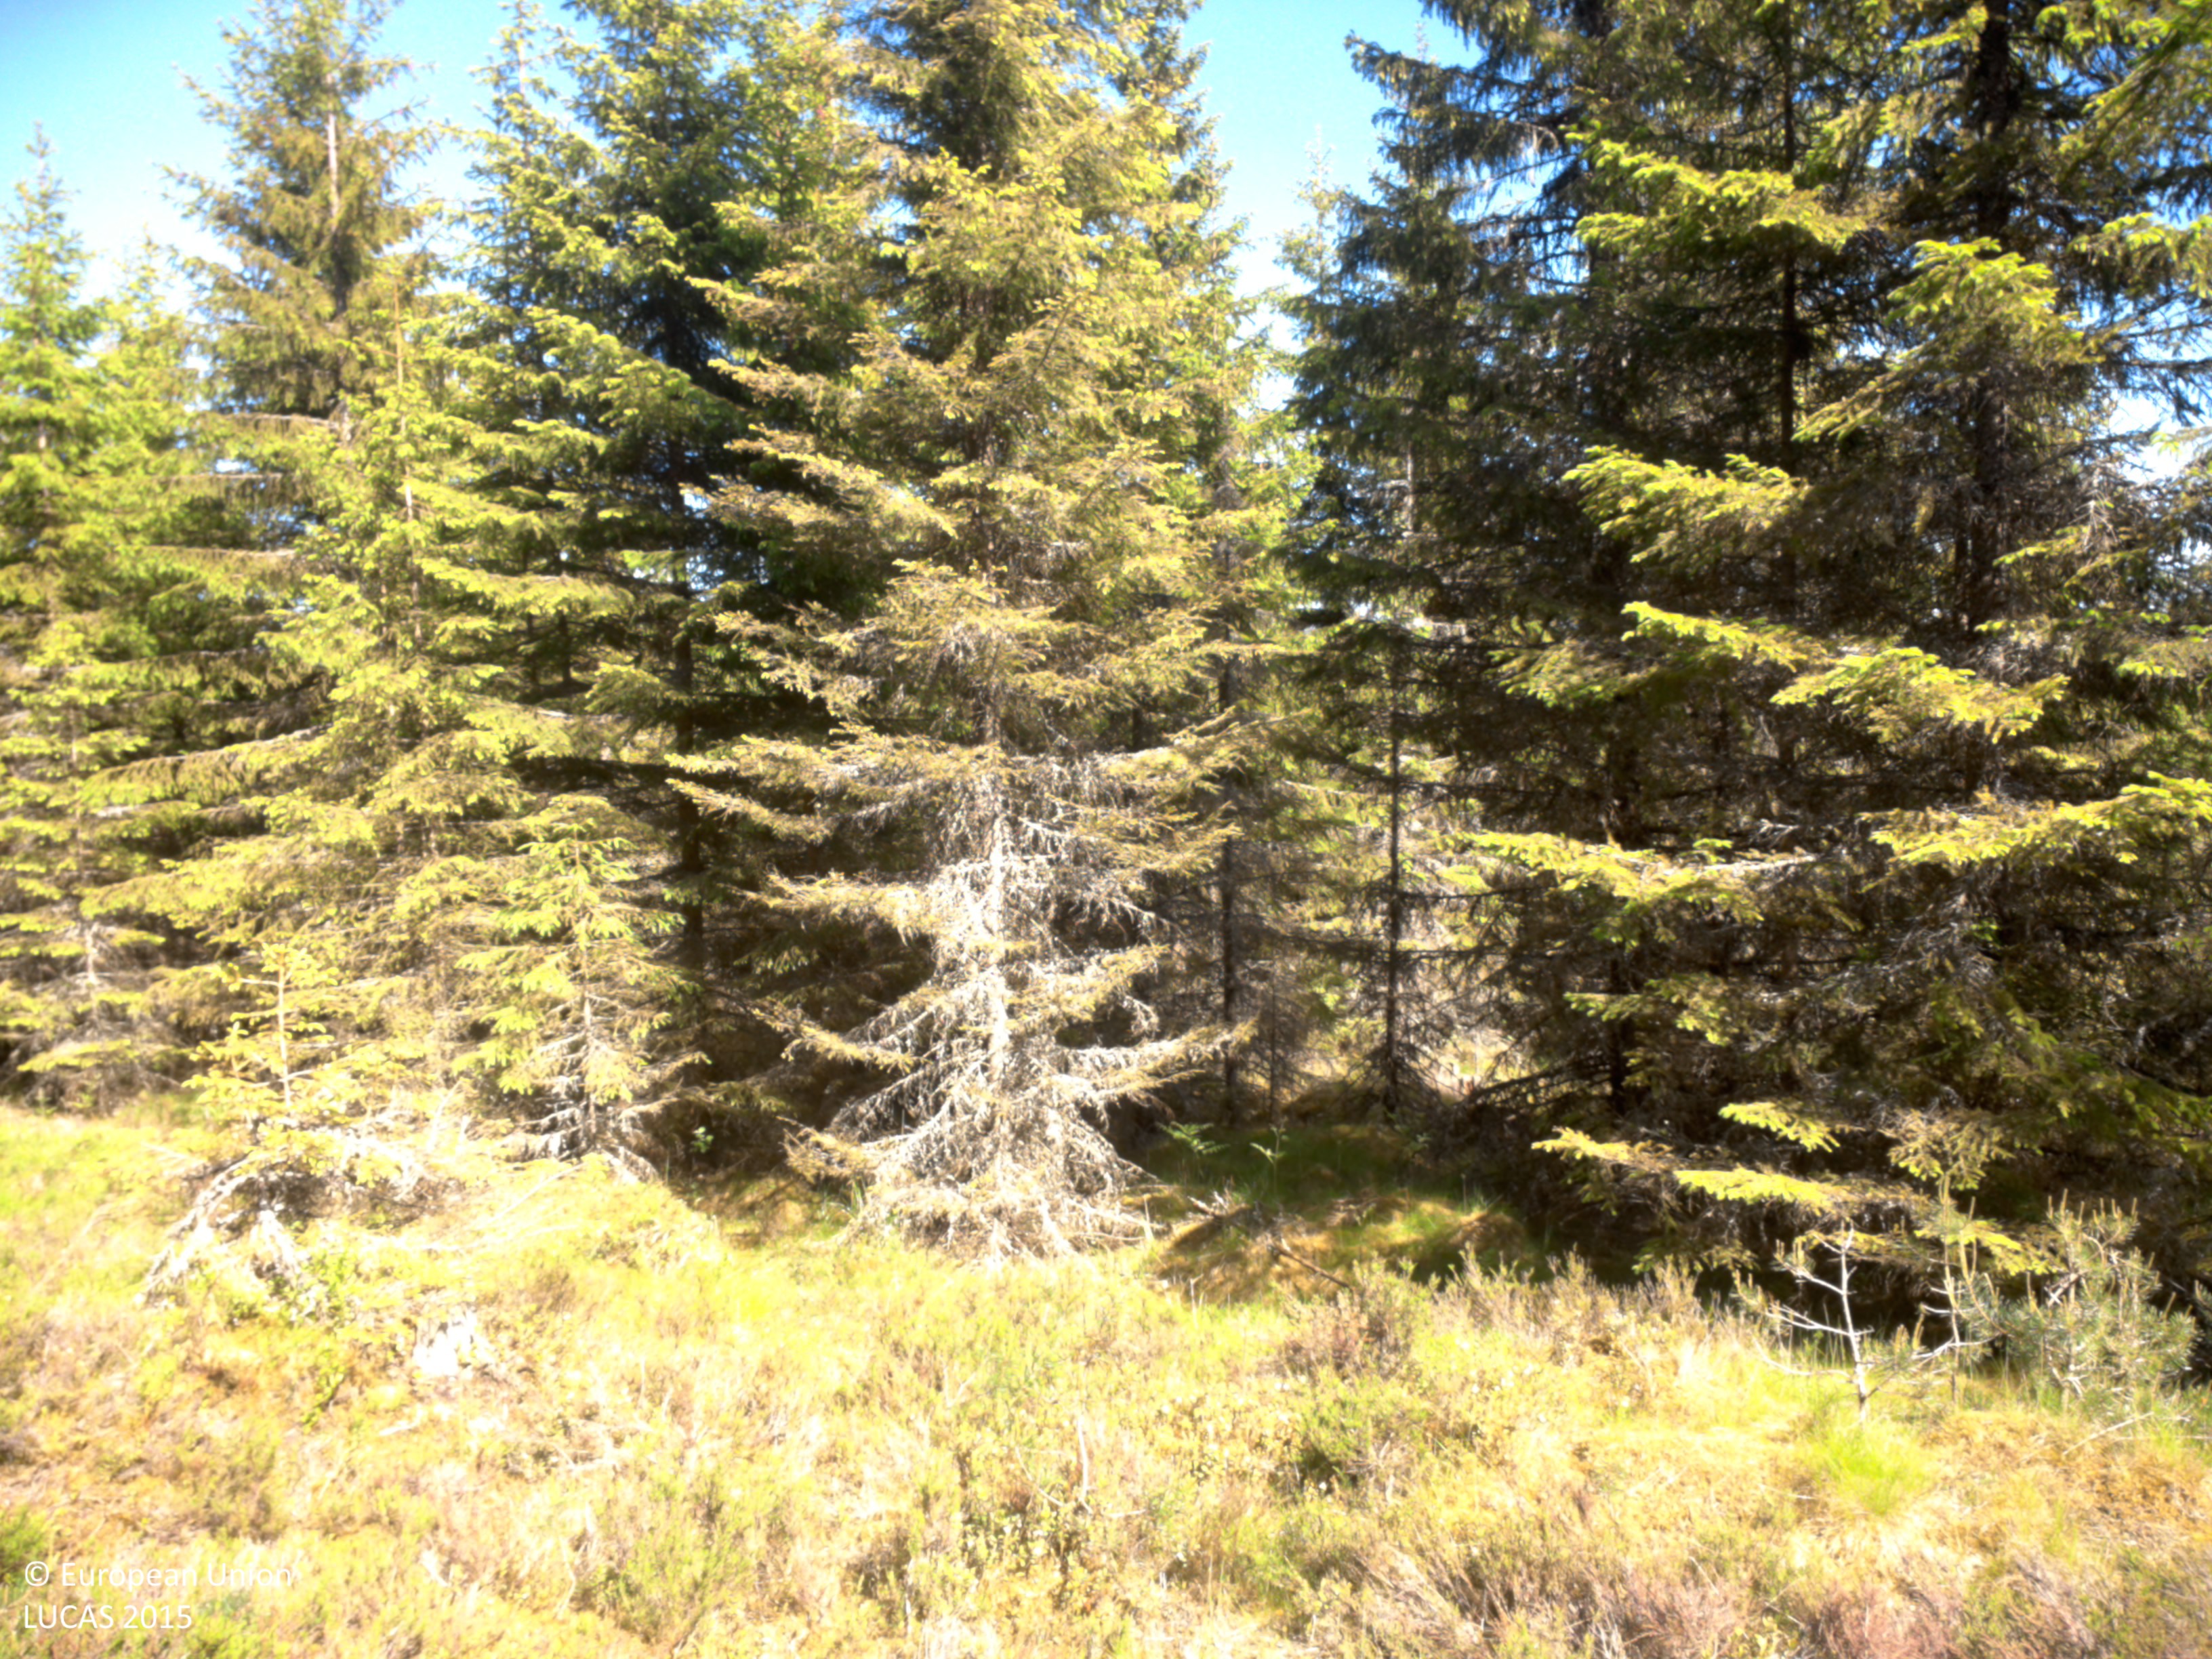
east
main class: Woodland
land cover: Spruce dominated coniferous woodland
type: boreal forest
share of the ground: 25 - 50 %
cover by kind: coniferous forest trees 40 %, shrubs 30 %, lichens and mosses 25 %, herbaceous plants 5 %
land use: Forestry
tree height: > 5 m
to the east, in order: Spruce dominated coniferous woodland
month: June
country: SE
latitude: 59.0678
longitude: 12.0358
